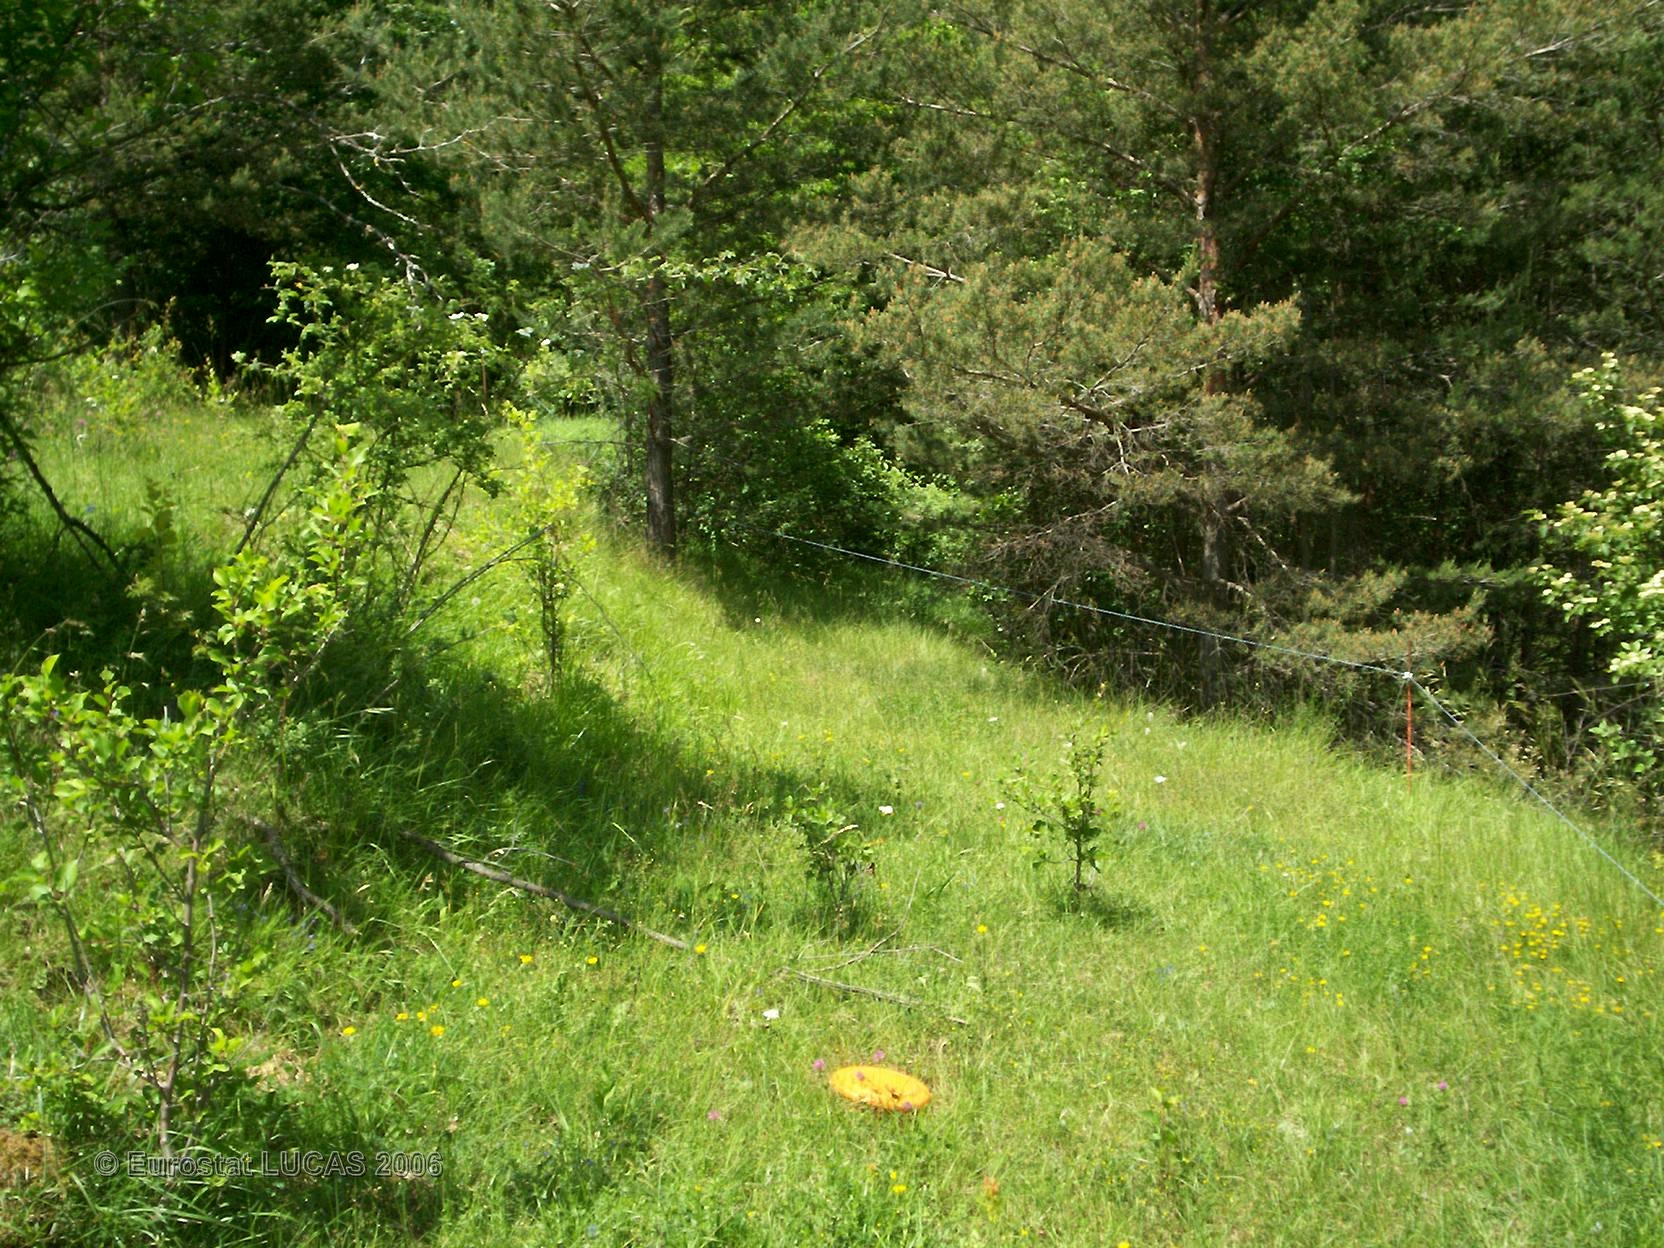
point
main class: Grassland
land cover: Grassland with sparse tree/shrub cover
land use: Agriculture (excluding fallow land and kitchen gardens)
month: May
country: FR
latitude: 44.0086
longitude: 7.2996
